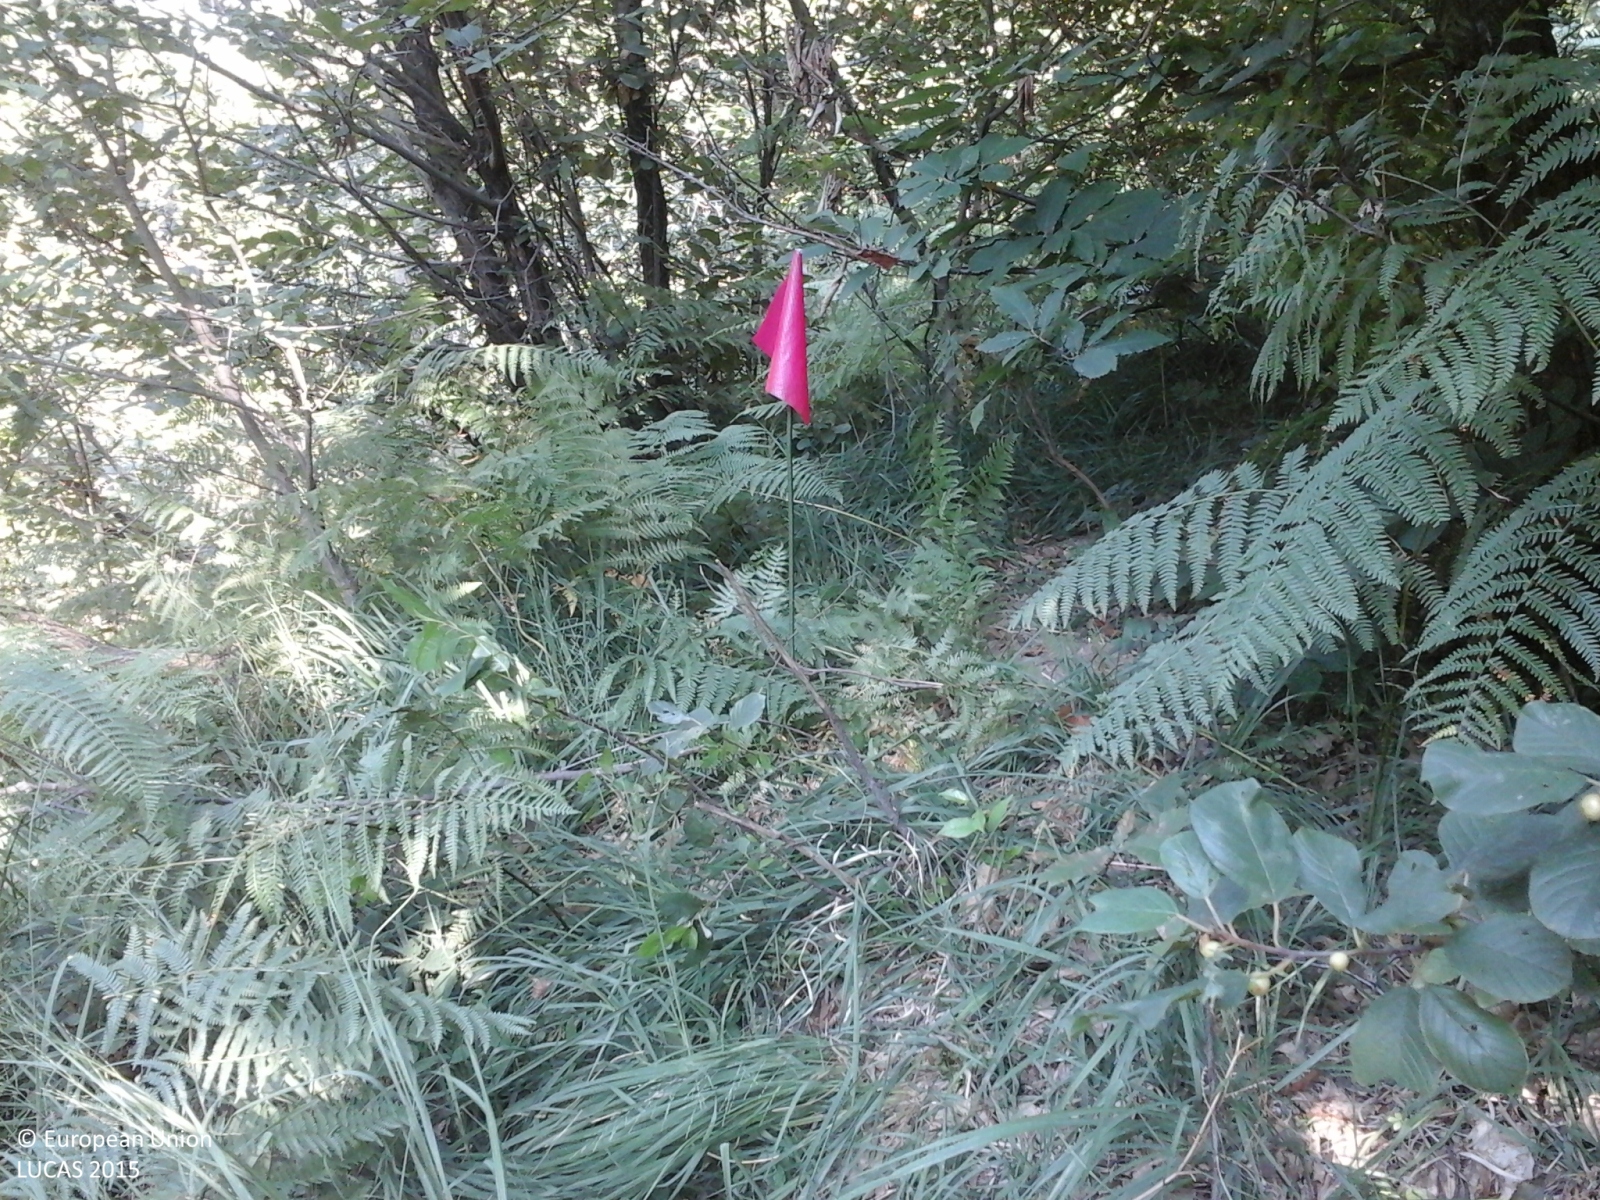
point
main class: Woodland
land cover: Broadleaved woodland
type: thermophilous deciduous forest
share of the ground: > 75 %
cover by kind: broadleaved forest trees 100 %
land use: Semi-natural and natural areas not in use
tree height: > 5 m
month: July
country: IT
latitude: 44.8563
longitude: 7.2842
